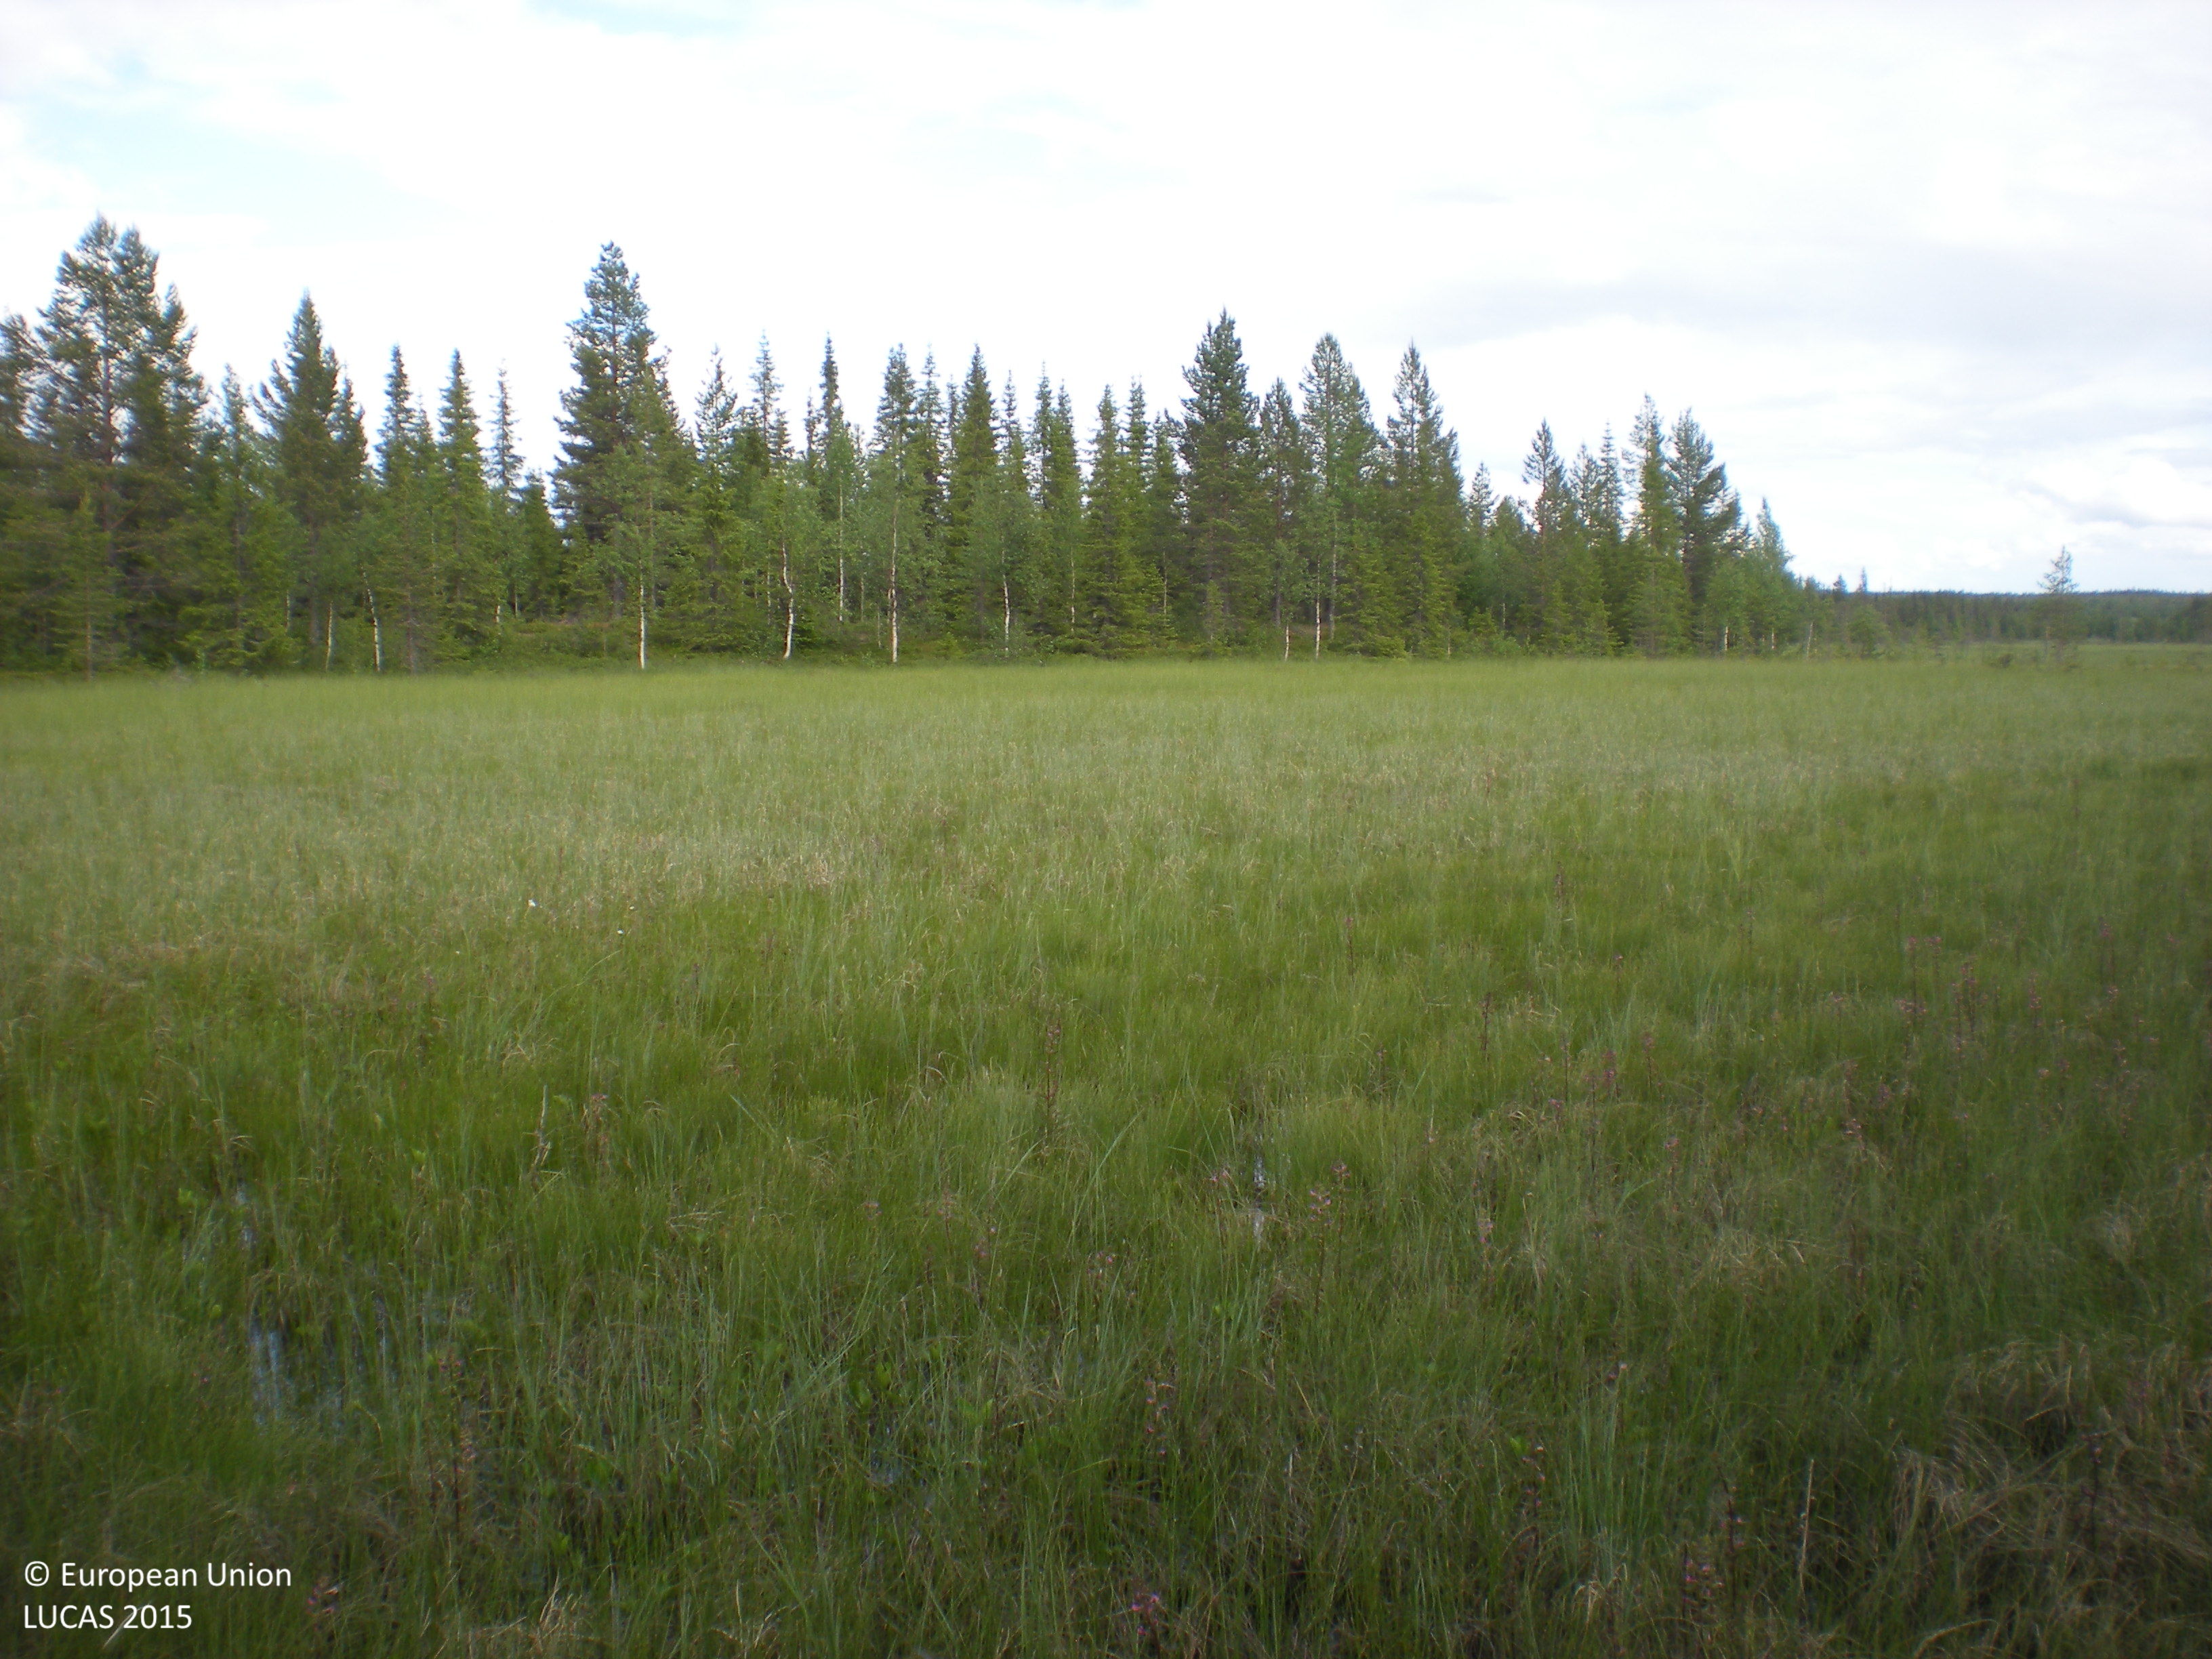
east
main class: Woodland
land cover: Spruce dominated mixed woodland
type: boreal forest
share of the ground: 50 - 75 %
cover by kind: coniferous forest trees 35 %, shrubs 30 %, broadleaved forest trees 25 %, lichens and mosses 10 %
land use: Forestry
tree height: > 5 m
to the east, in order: Spruce dominated mixed woodland; Peatbogs
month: July
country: SE
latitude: 65.6994
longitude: 17.7326
